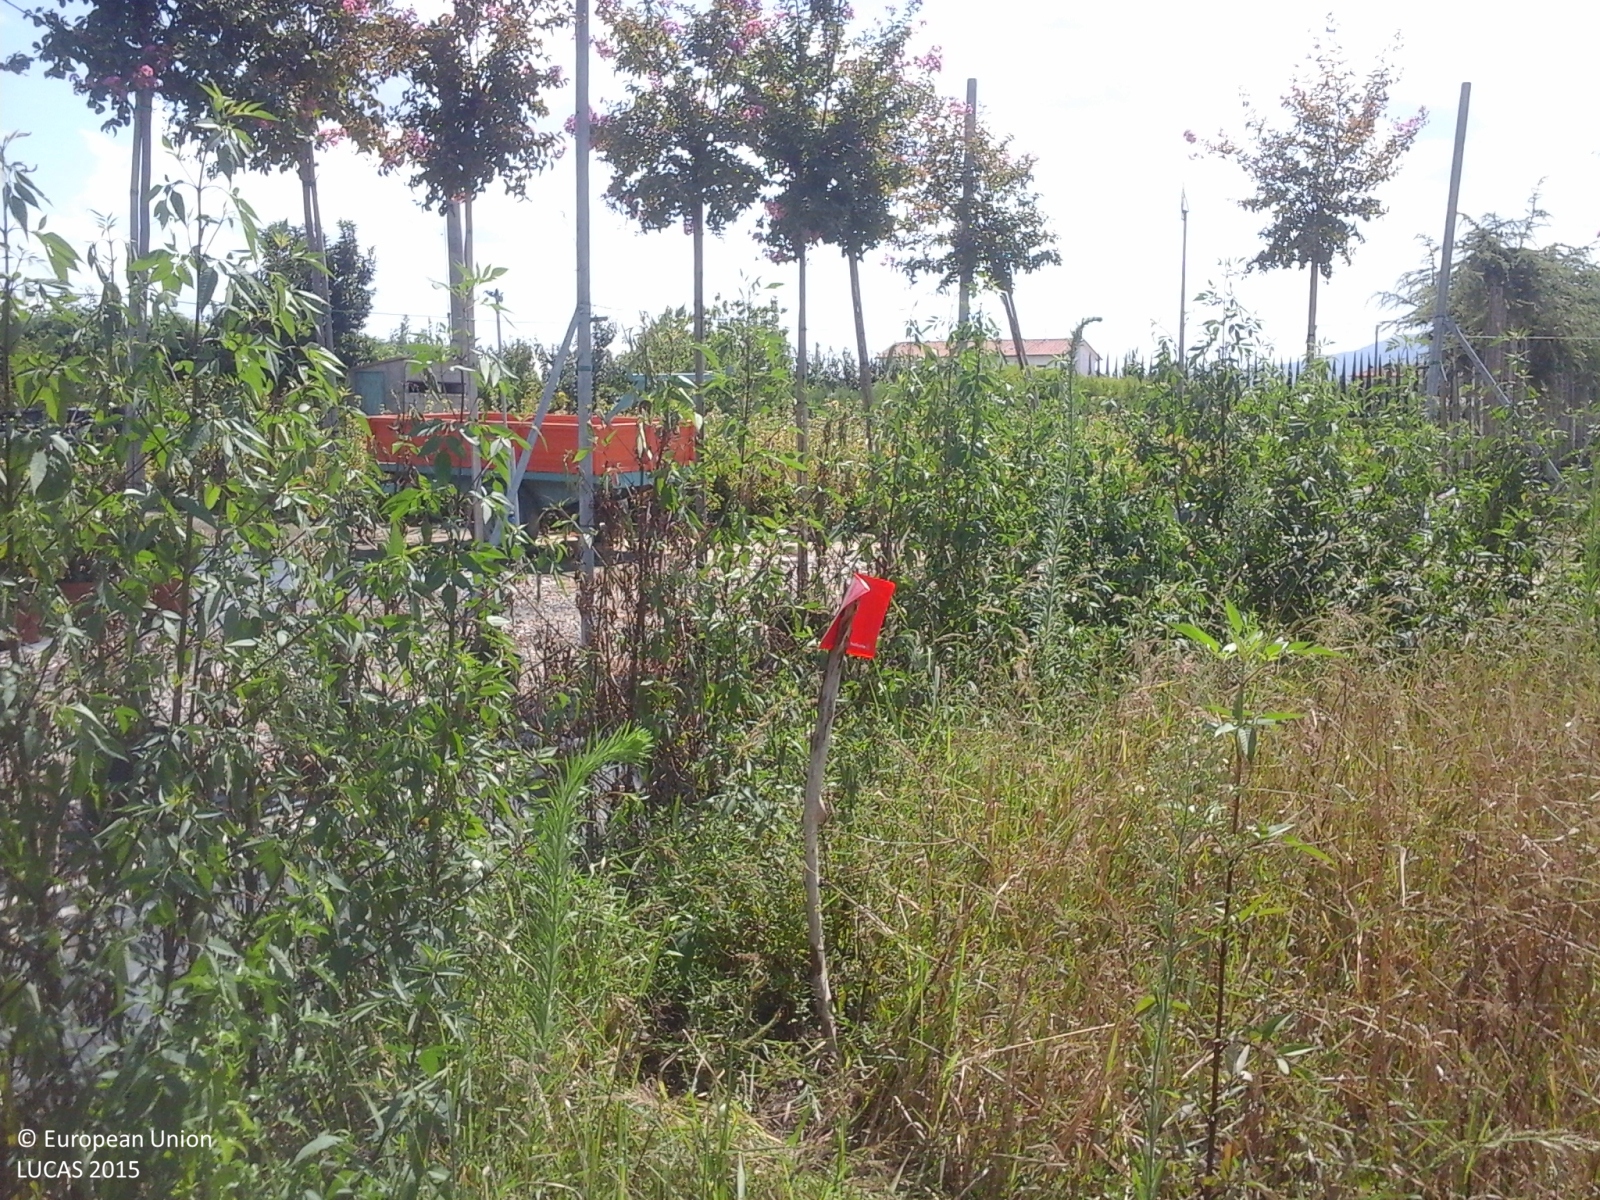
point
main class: Grassland
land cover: Spontaneously vegetated surfaces
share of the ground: > 75 %
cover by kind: herbaceous plants 95 %, shrubs 5 %
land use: Agriculture (excluding fallow land and kitchen gardens)
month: August
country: IT
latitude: 43.9132
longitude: 10.9564
